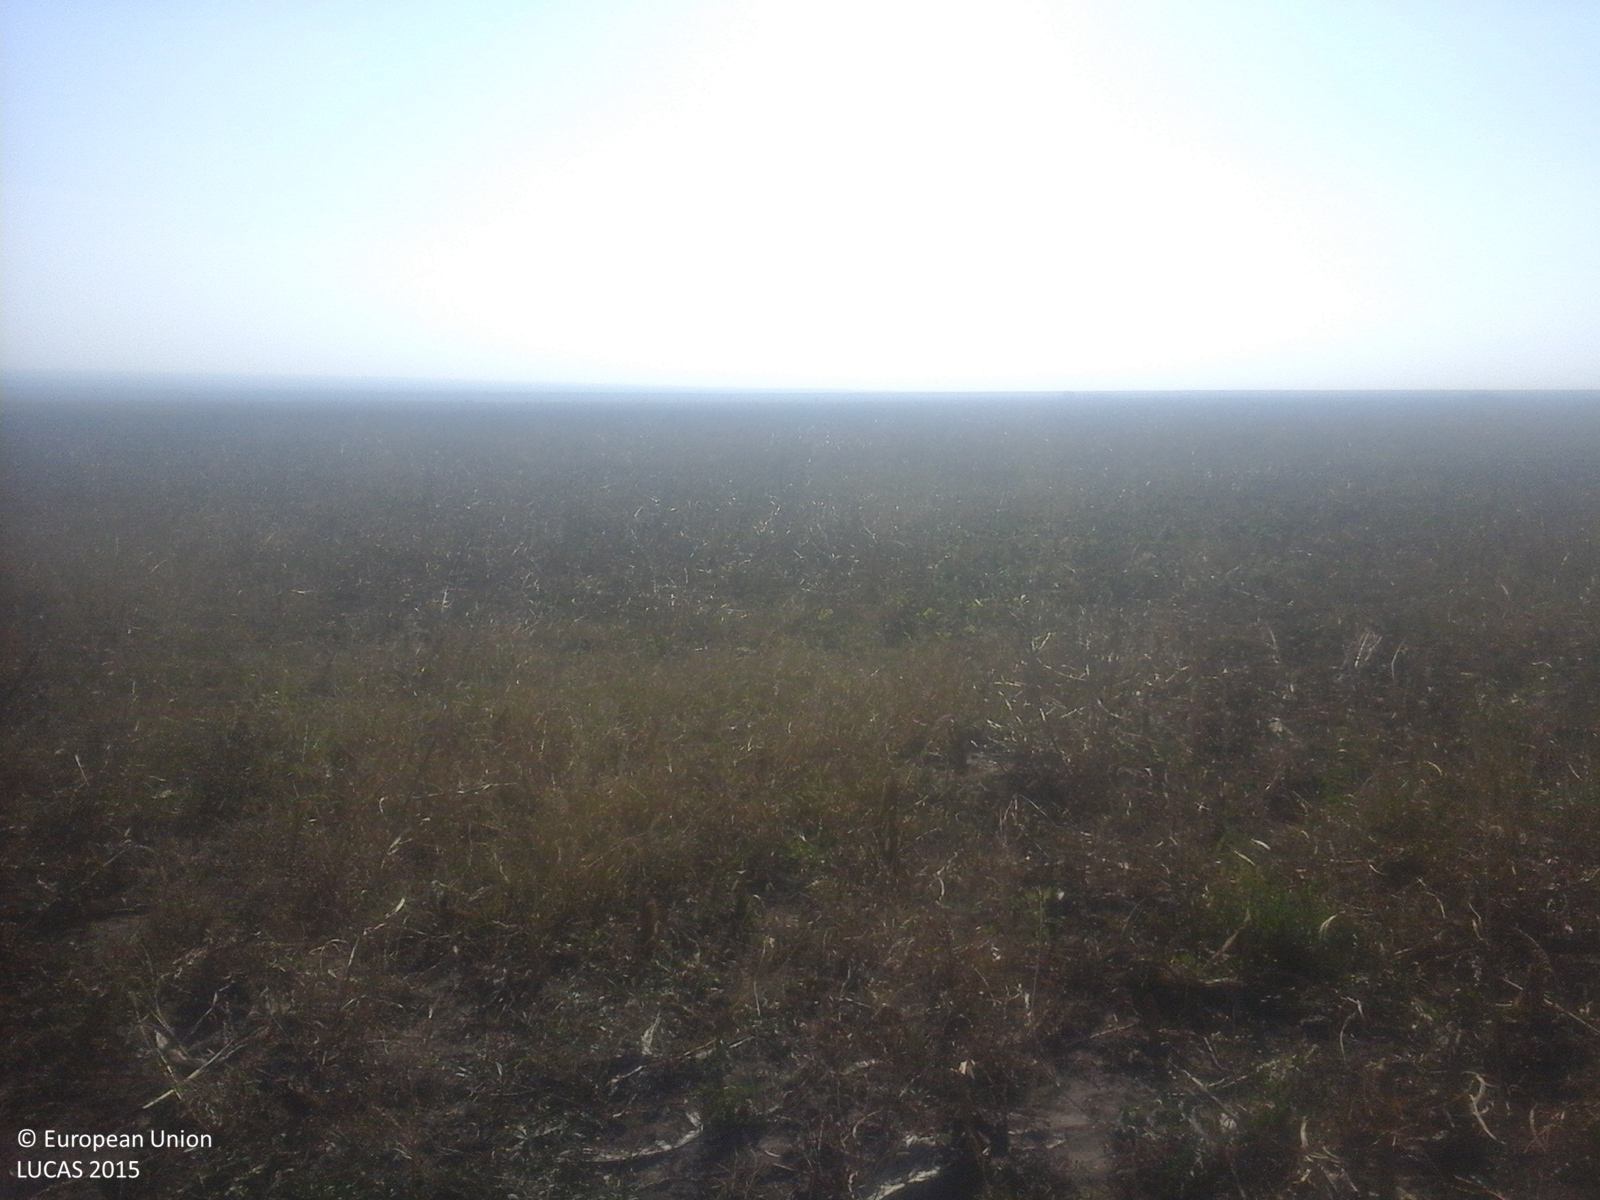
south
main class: Cropland
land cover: Maize
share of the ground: 10 - 25 %
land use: Agriculture (excluding fallow land and kitchen gardens)
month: October
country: RO
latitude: 45.3499
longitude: 26.9723
